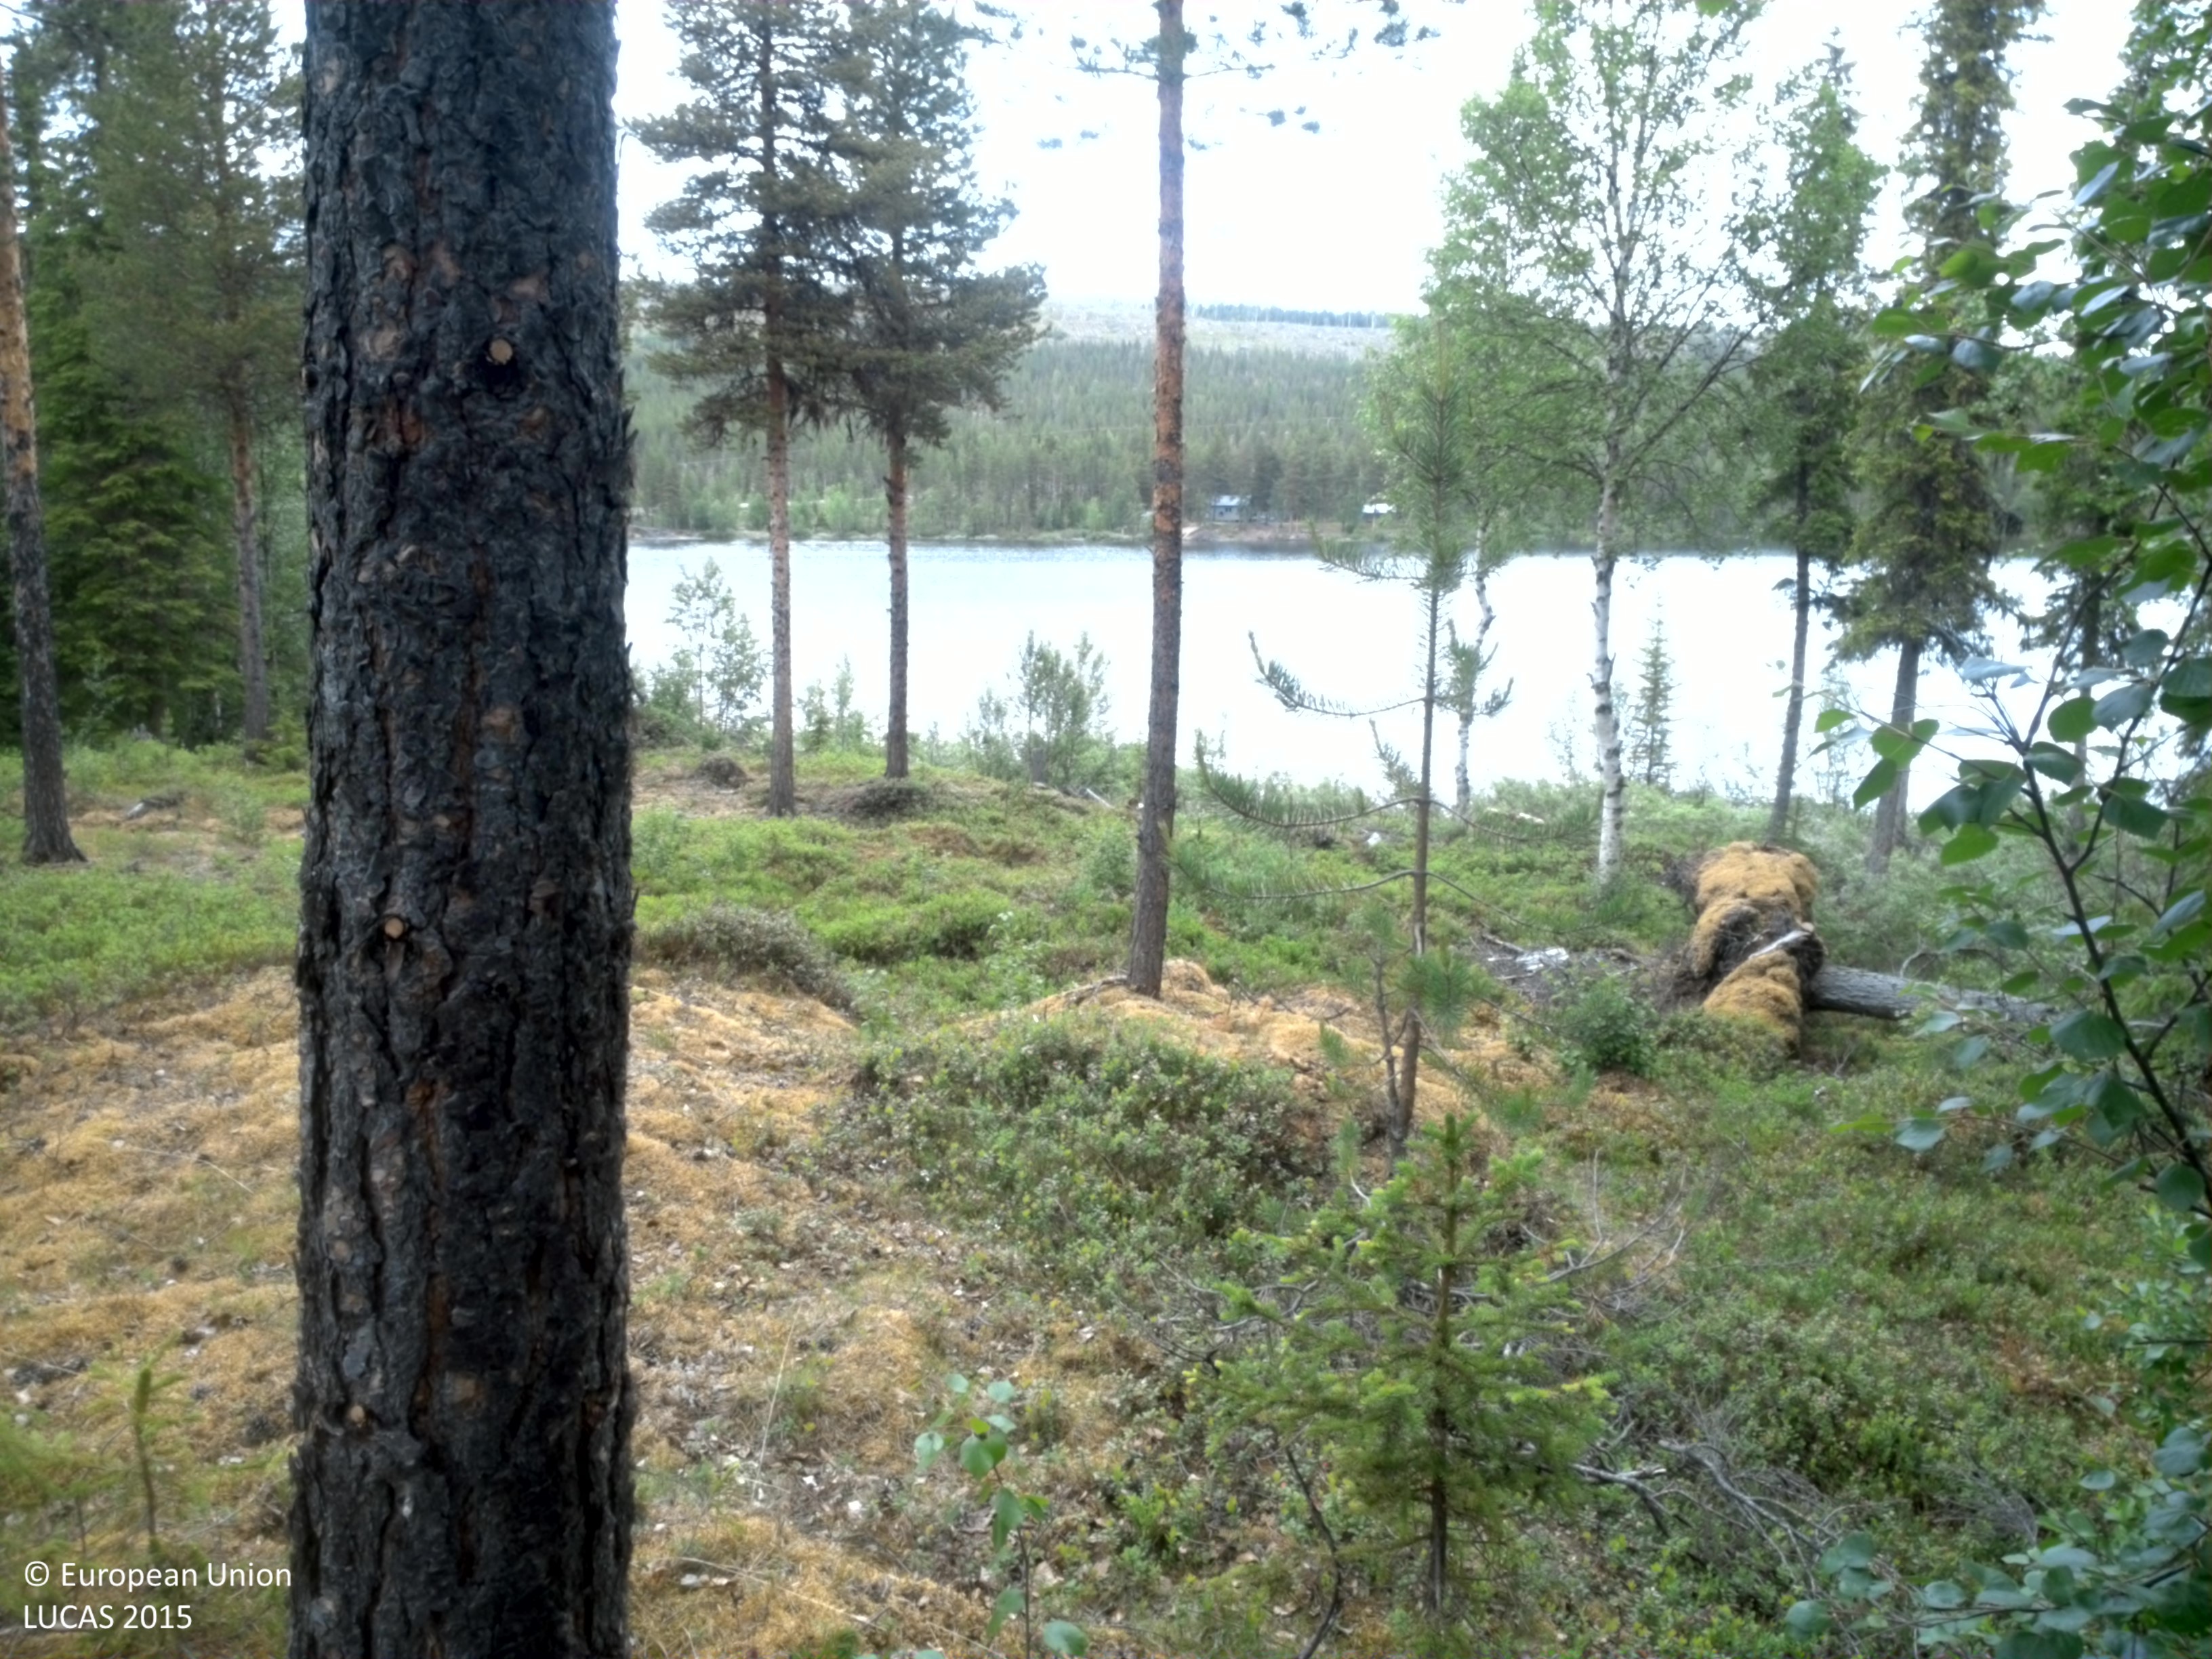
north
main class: Woodland
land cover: Pine dominated mixed woodland
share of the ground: 10 - 25 %
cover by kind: shrubs 75 %, broadleaved forest trees 15 %, coniferous forest trees 10 %
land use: Forestry
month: July
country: SE
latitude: 66.9087
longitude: 18.3328
